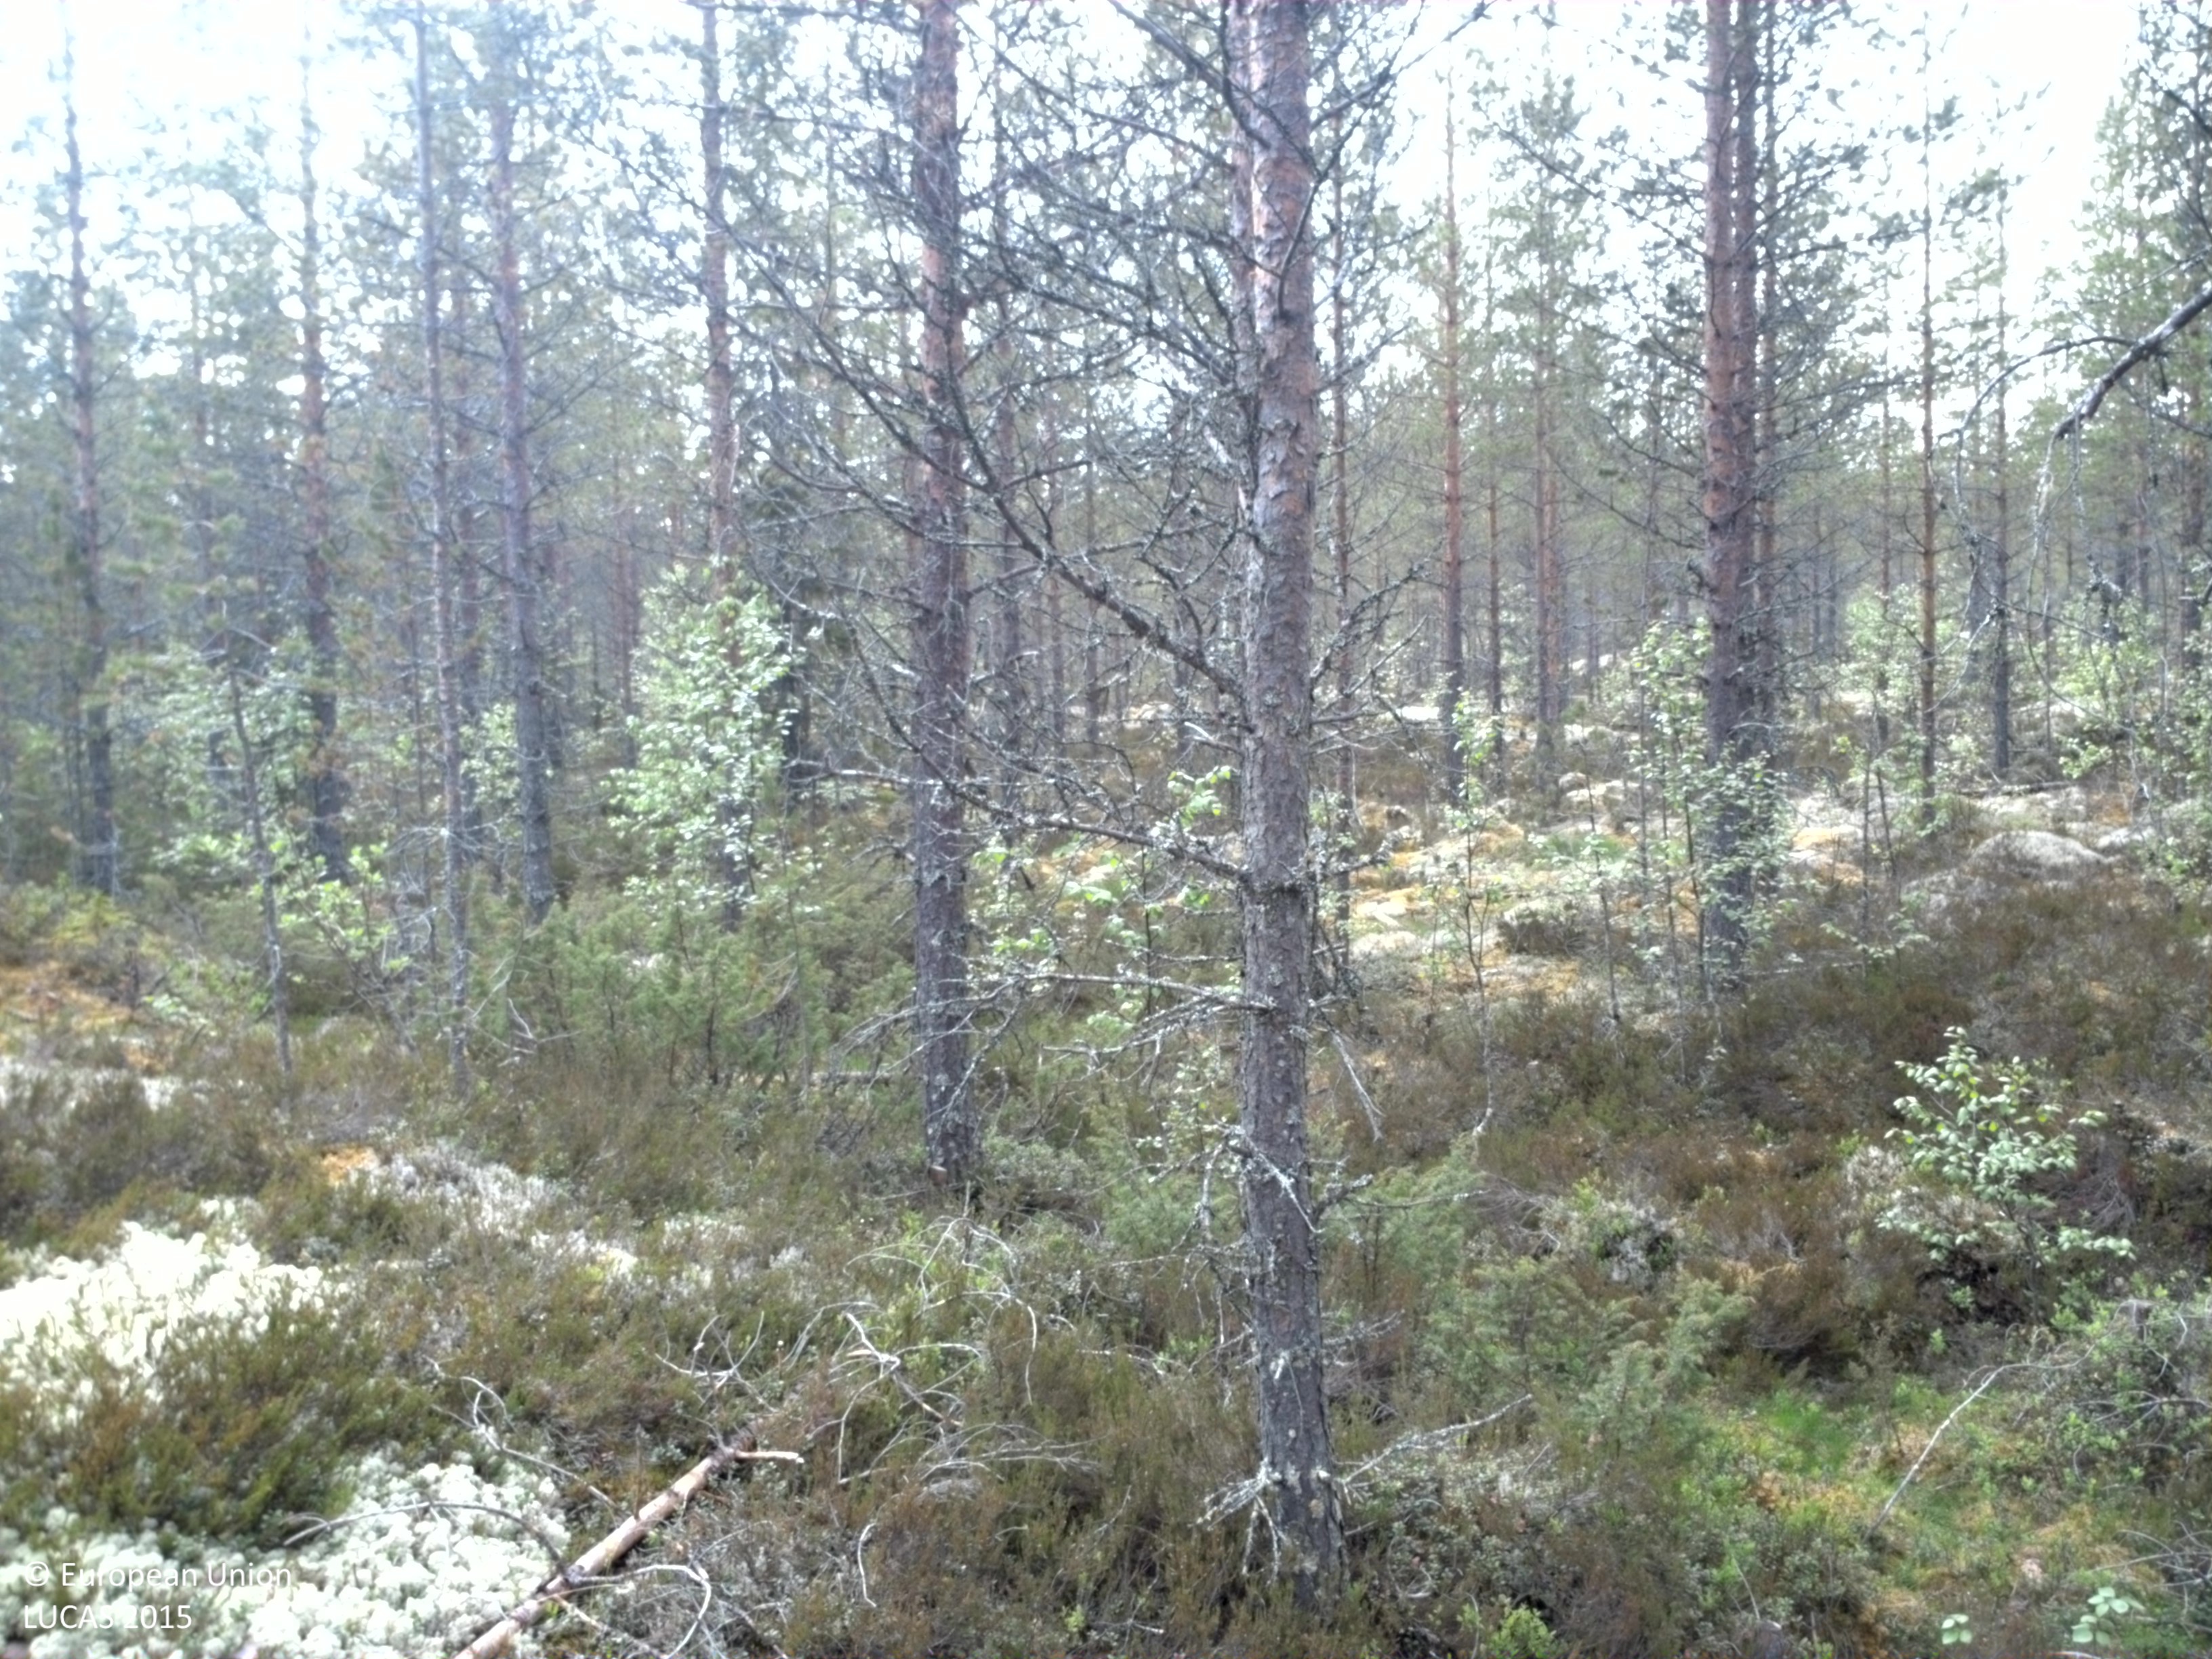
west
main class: Woodland
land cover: Pine dominated coniferous woodland
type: boreal forest
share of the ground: 25 - 50 %
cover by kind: coniferous forest trees 40 %, lichens and mosses 35 %, herbaceous plants 25 %
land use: Forestry
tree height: > 5 m
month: June
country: SE
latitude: 61.3795
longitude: 13.5619
